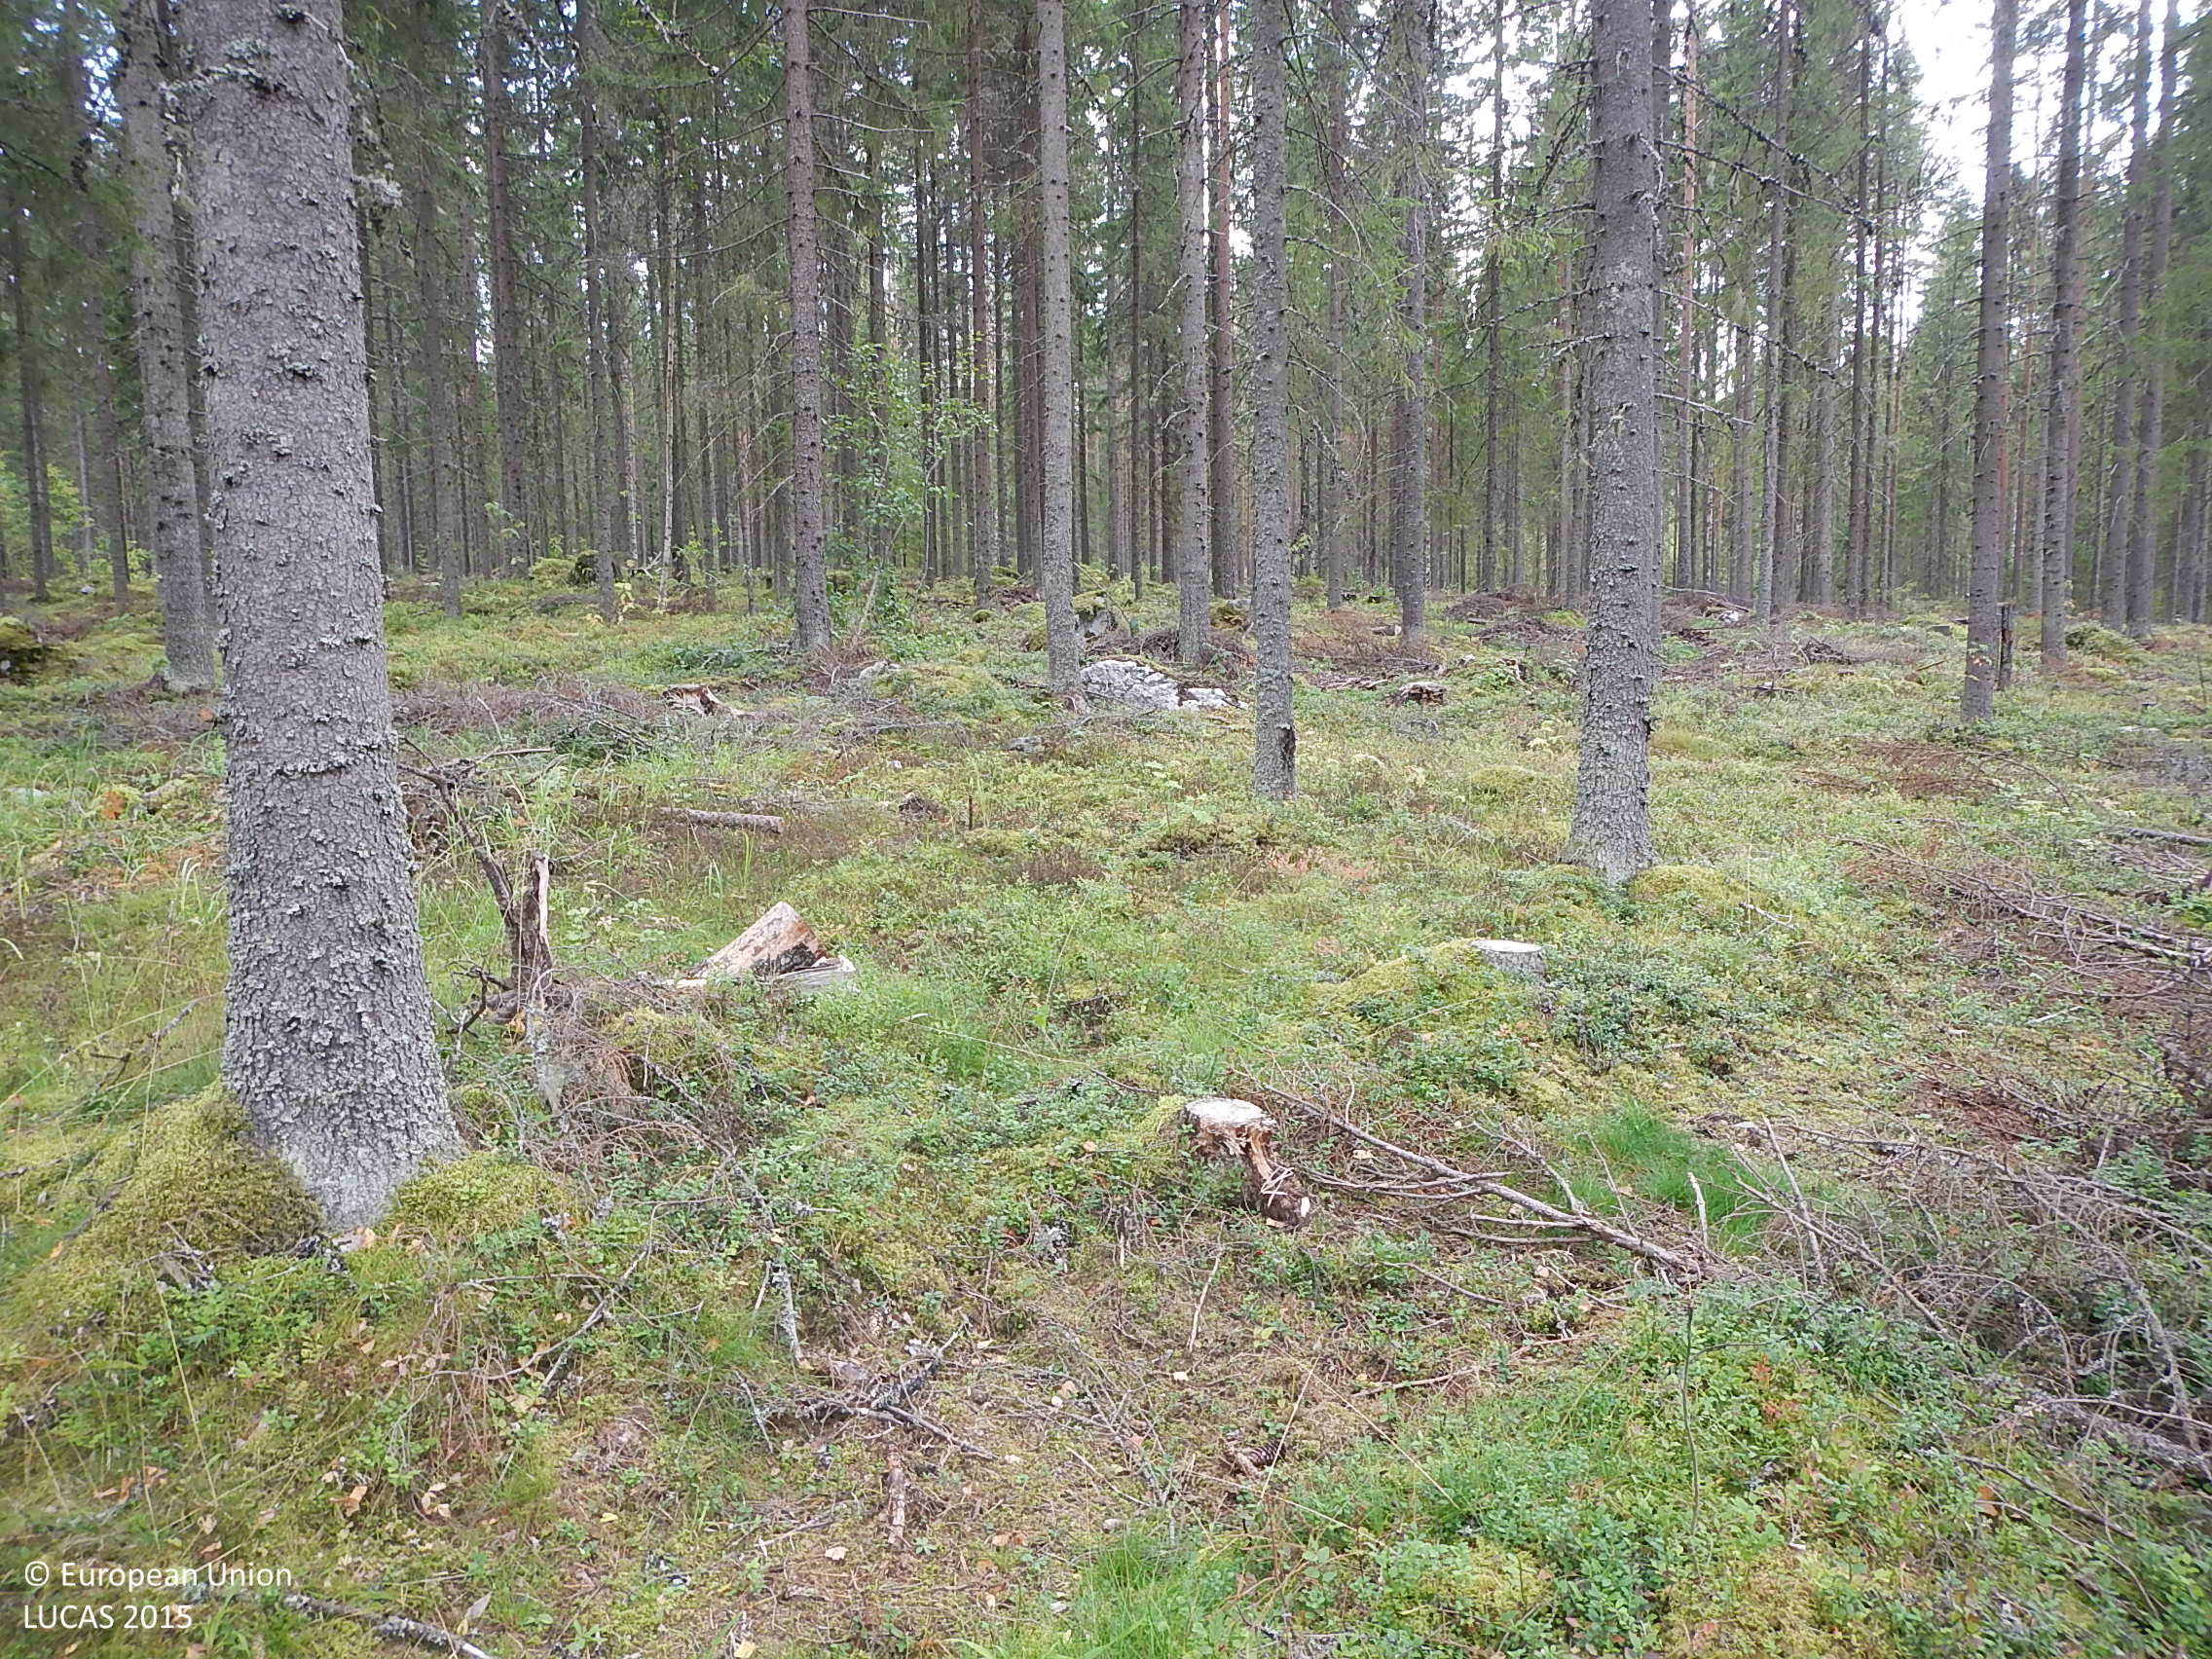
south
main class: Woodland
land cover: Spruce dominated coniferous woodland
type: boreal forest
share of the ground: 50 - 75 %
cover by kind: coniferous forest trees 50 %, shrubs 40 %, lichens and mosses 10 %
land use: Forestry
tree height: > 5 m
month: September
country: FI
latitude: 61.5519
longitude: 22.5782
